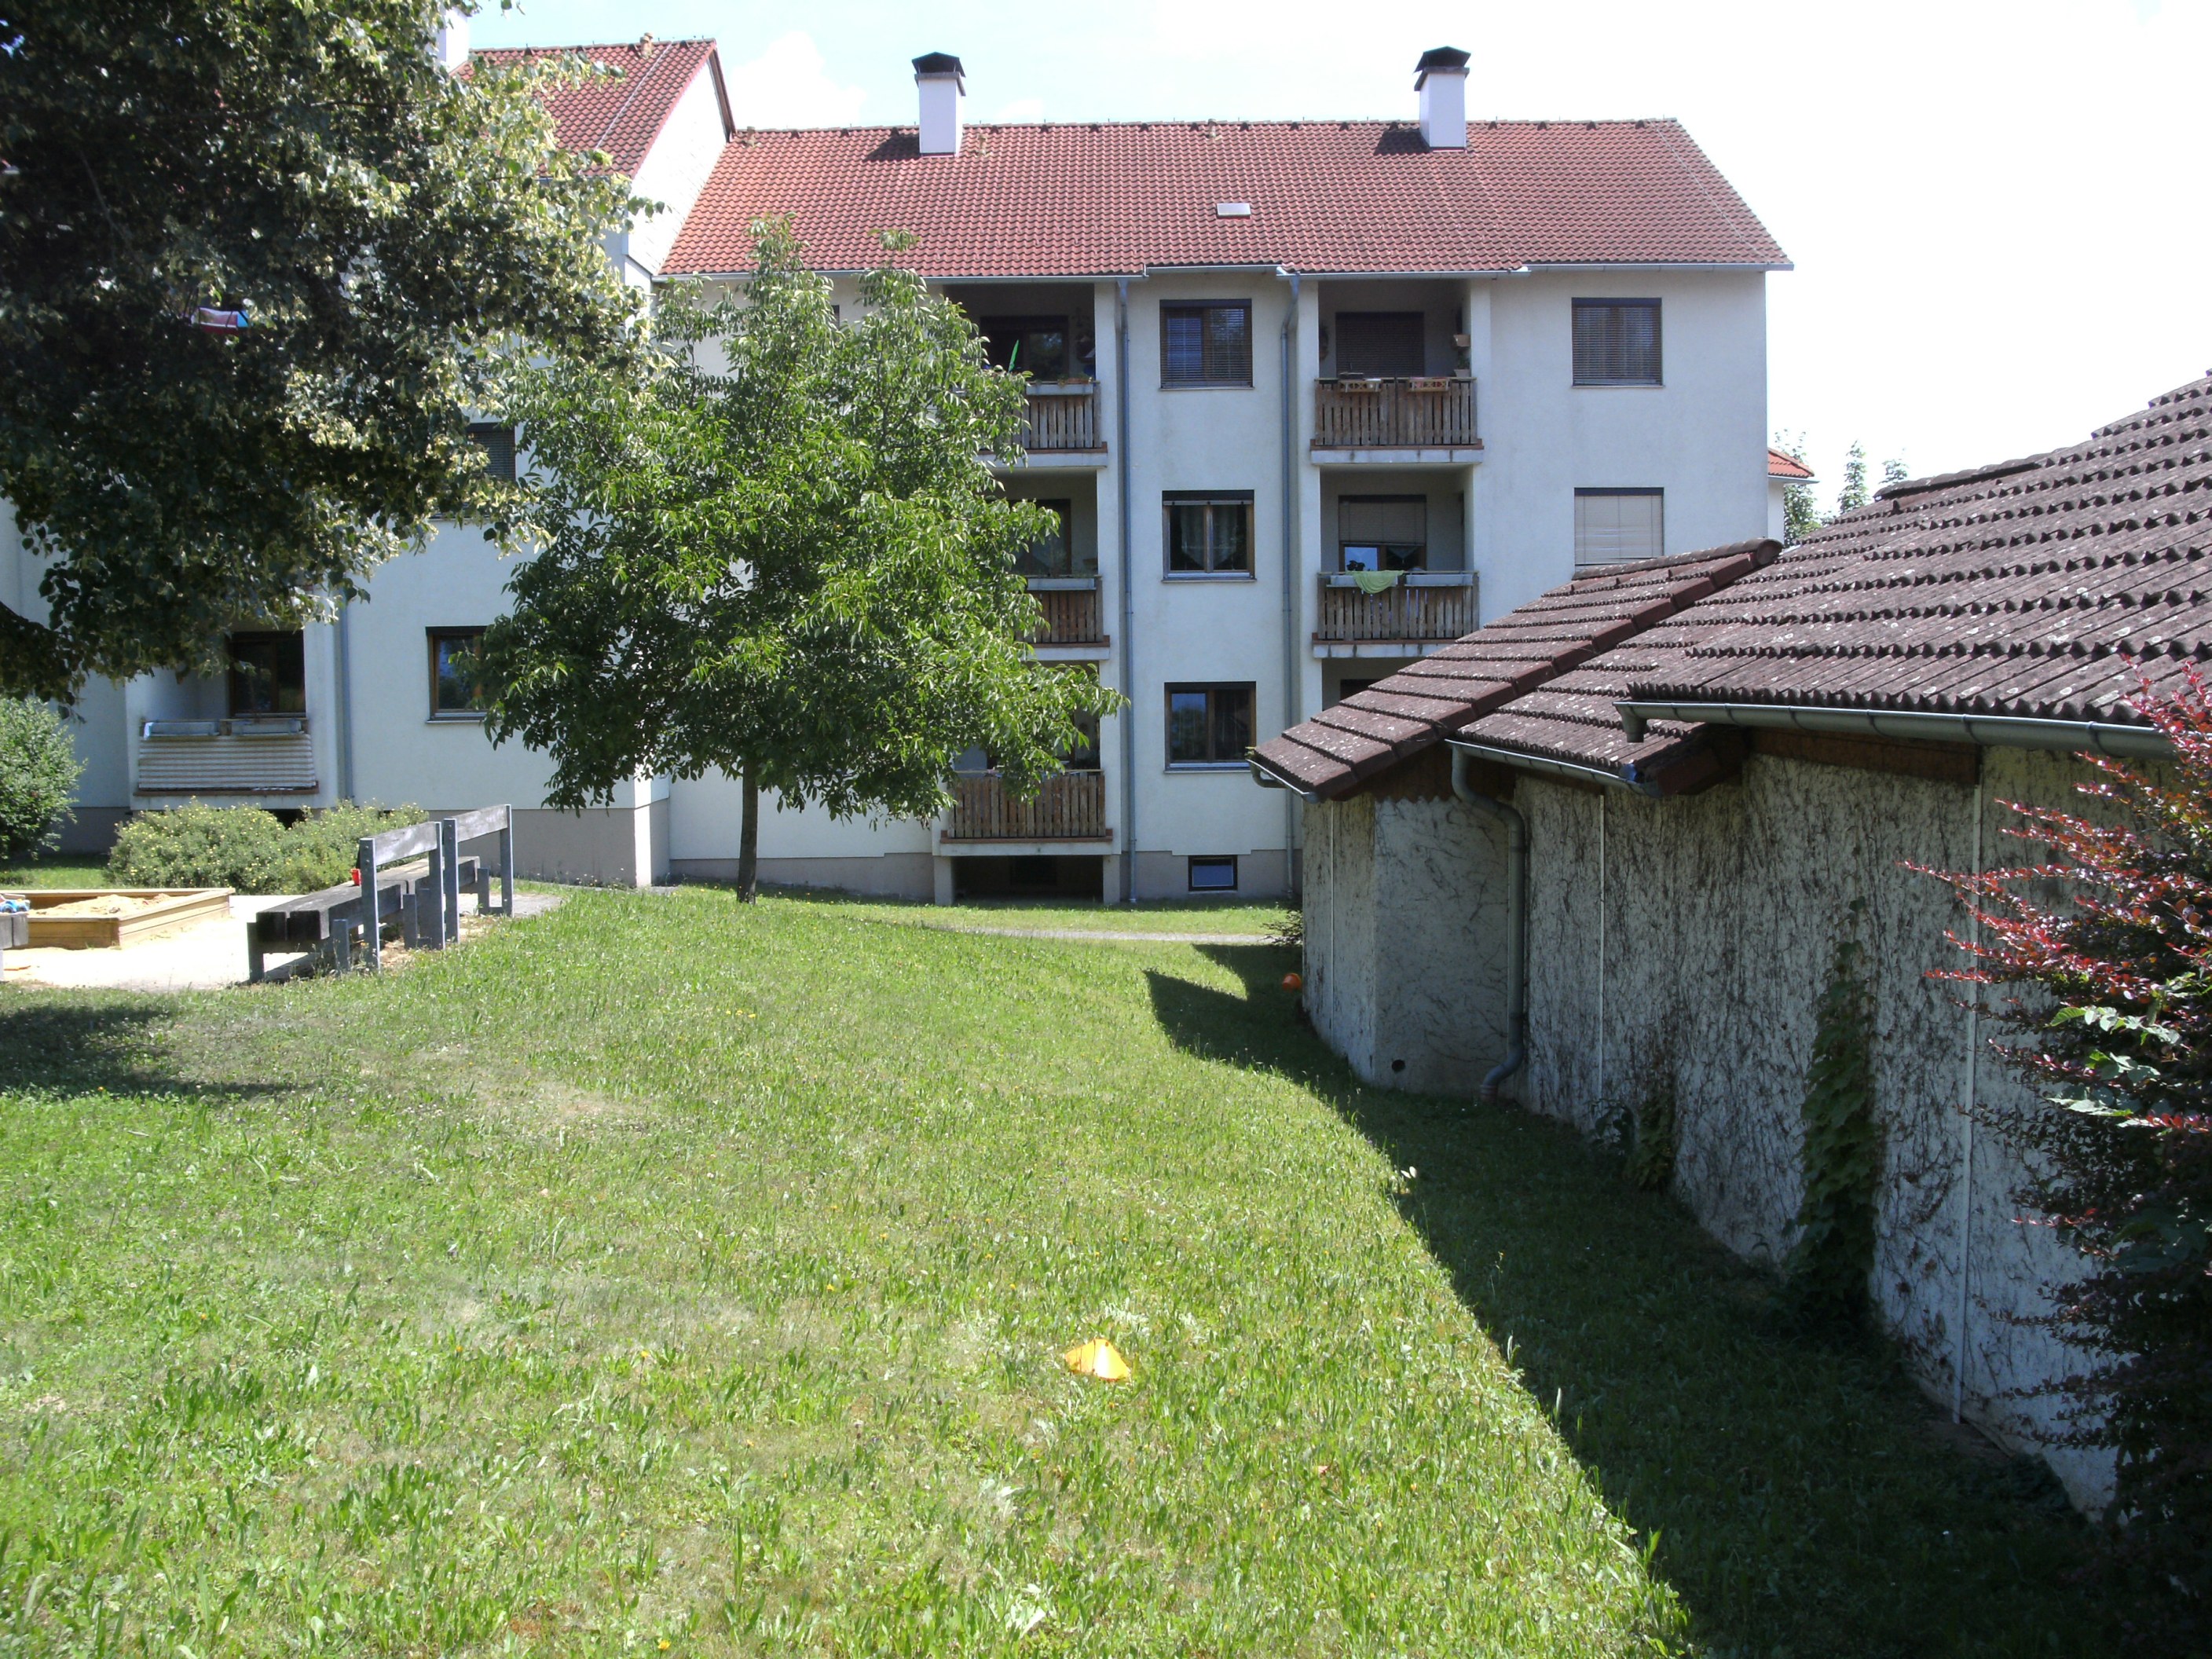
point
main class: Grassland
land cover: Grassland with sparse tree/shrub cover
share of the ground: > 75 %
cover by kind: herbaceous plants 95 %, broadleaved forest trees 5 %
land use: Residential
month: June
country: AT
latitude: 48.2118
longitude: 13.8080
